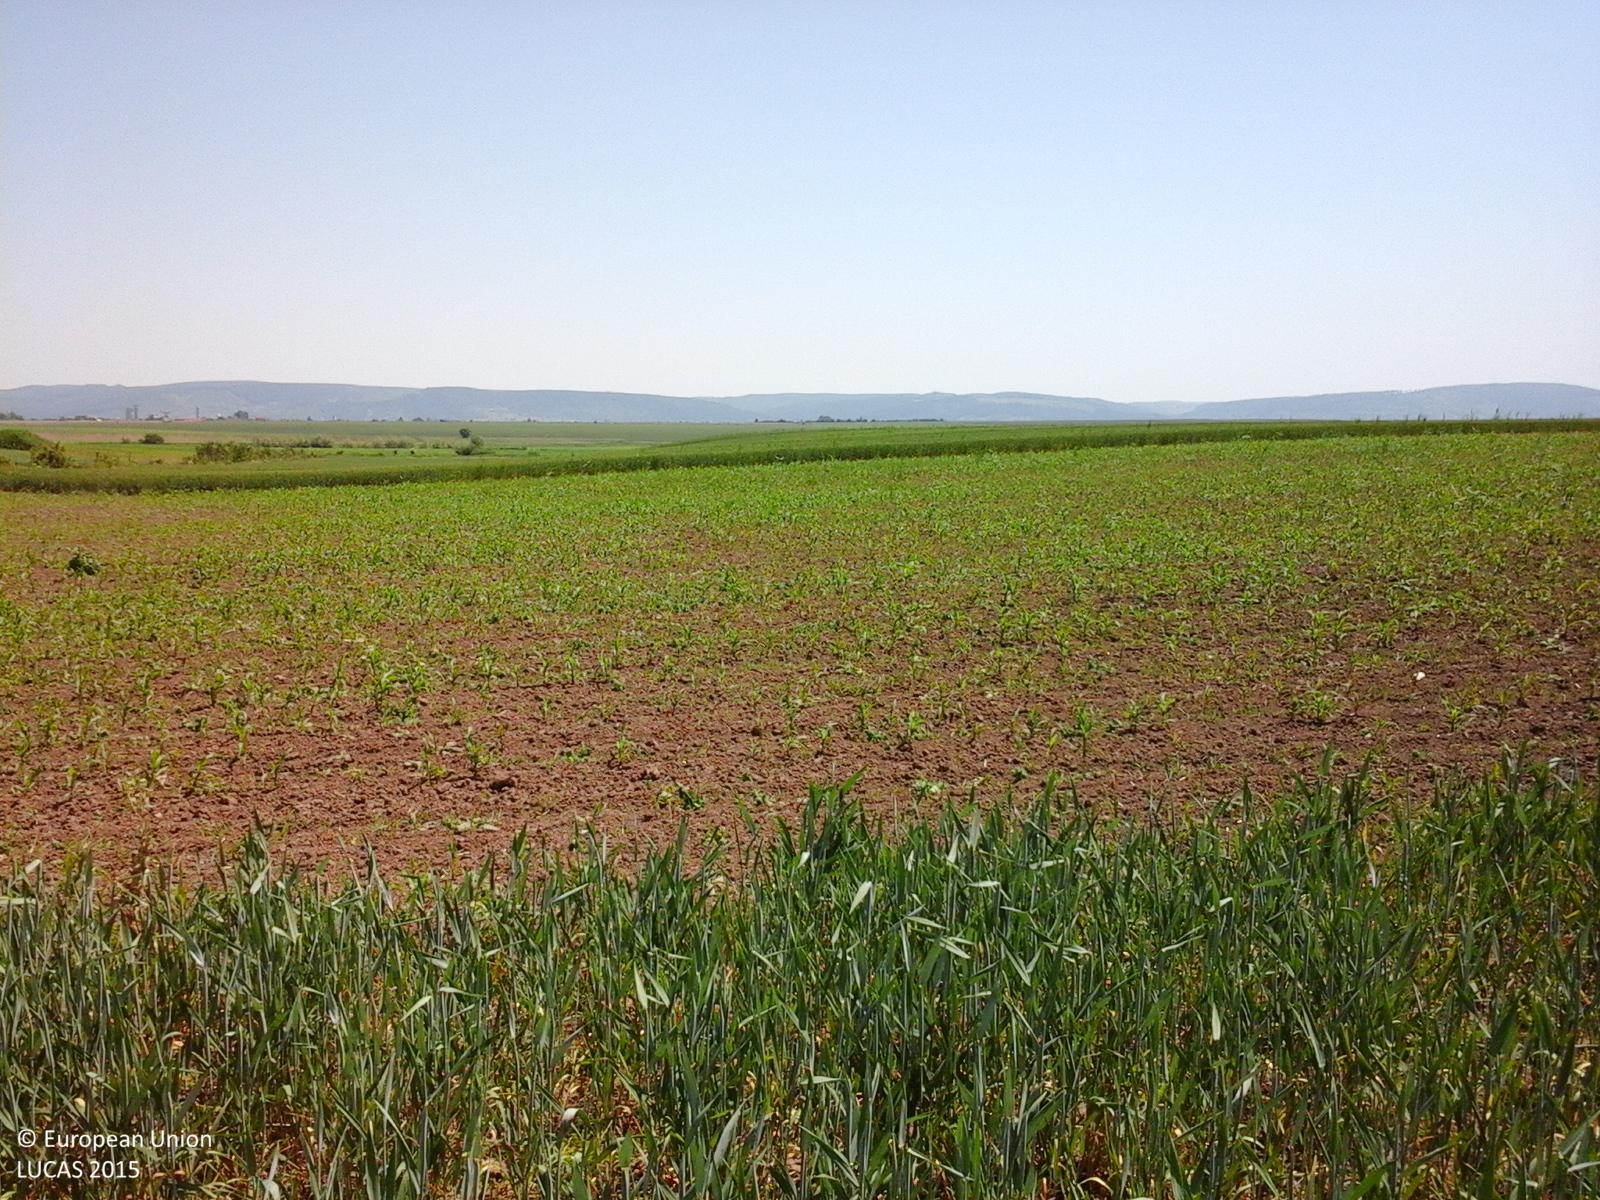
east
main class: Cropland
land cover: Common wheat
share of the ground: > 75 %
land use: Agriculture (excluding fallow land and kitchen gardens)
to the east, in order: Common wheat; Maize; Common wheat
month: June
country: RO
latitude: 46.5032
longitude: 26.8898
